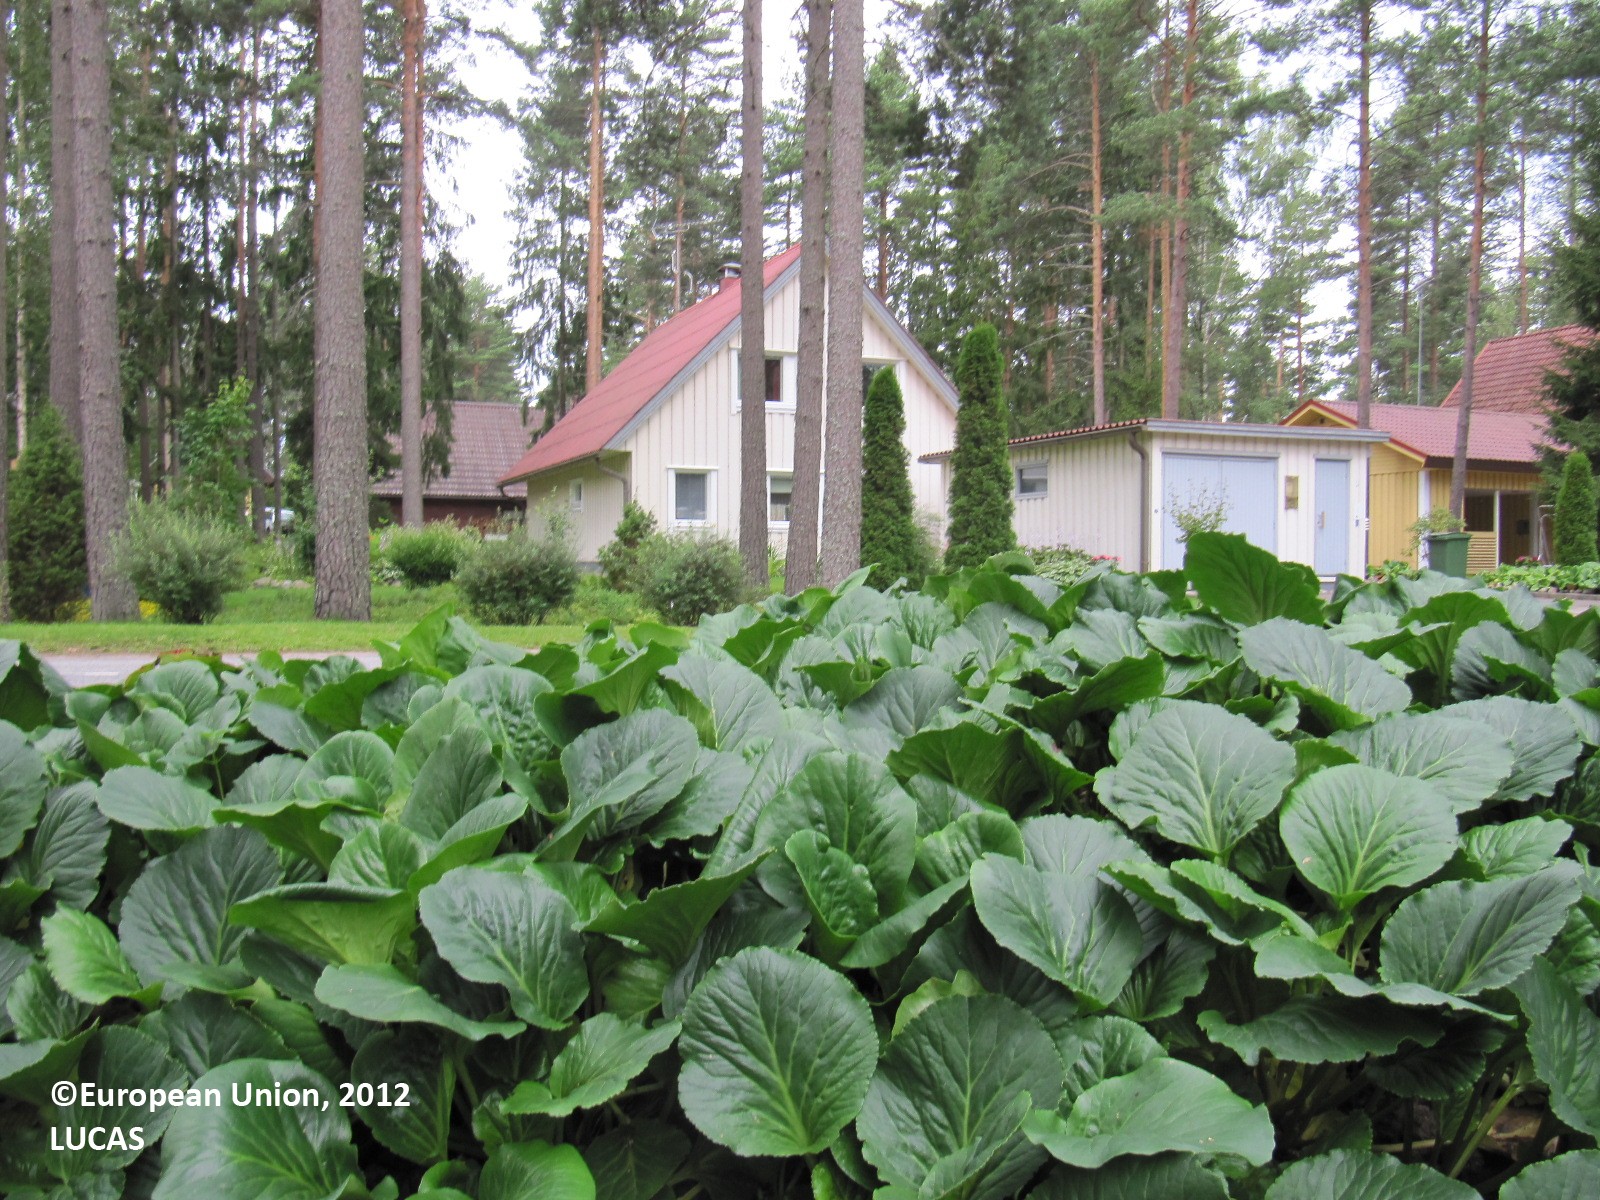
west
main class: Grassland
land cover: Grassland with sparse tree/shrub cover
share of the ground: > 75 %
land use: Residential
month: August
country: FI
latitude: 60.4045
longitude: 23.1323
